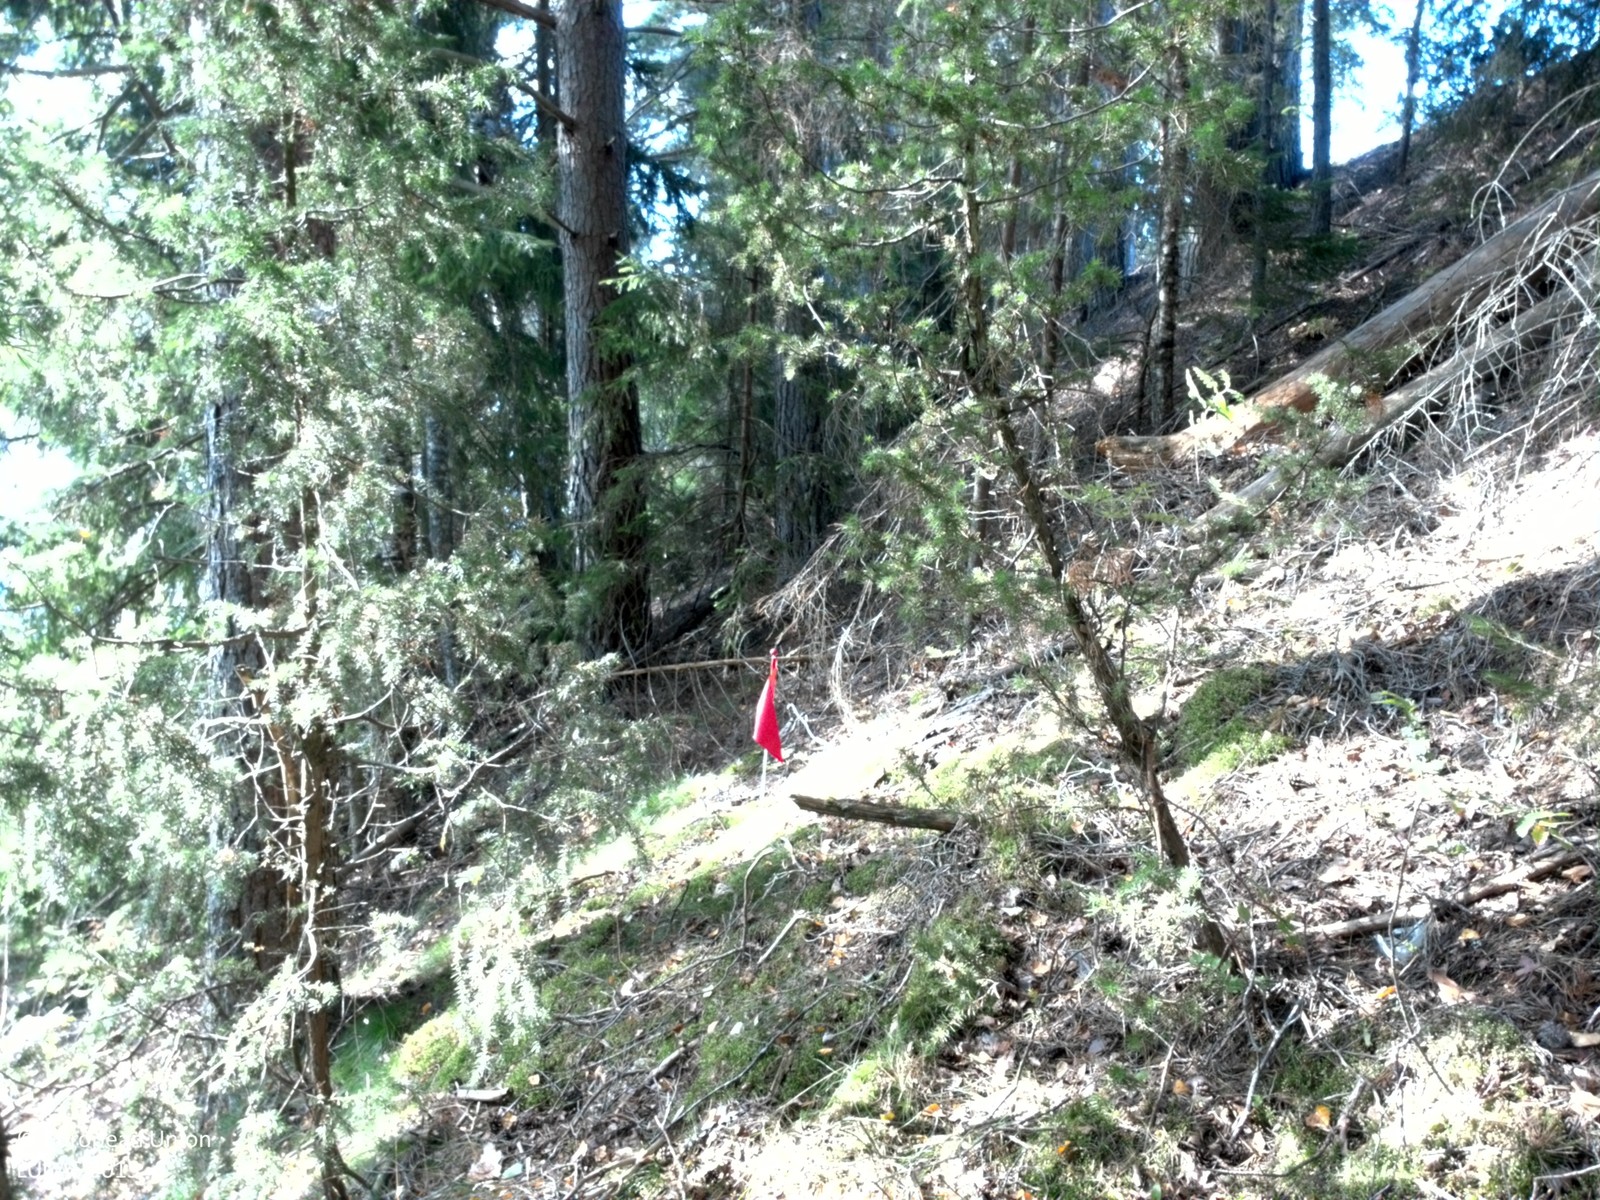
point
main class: Woodland
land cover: Pine dominated coniferous woodland
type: boreal forest
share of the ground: 50 - 75 %
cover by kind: coniferous forest trees 60 %, lichens and mosses 20 %, consolidated bare surface 10 %, broadleaved forest trees 5 %, herbaceous plants 5 %
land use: Amenities, museums, leisure
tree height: > 5 m
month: August
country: SE
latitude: 59.5082
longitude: 13.4373
